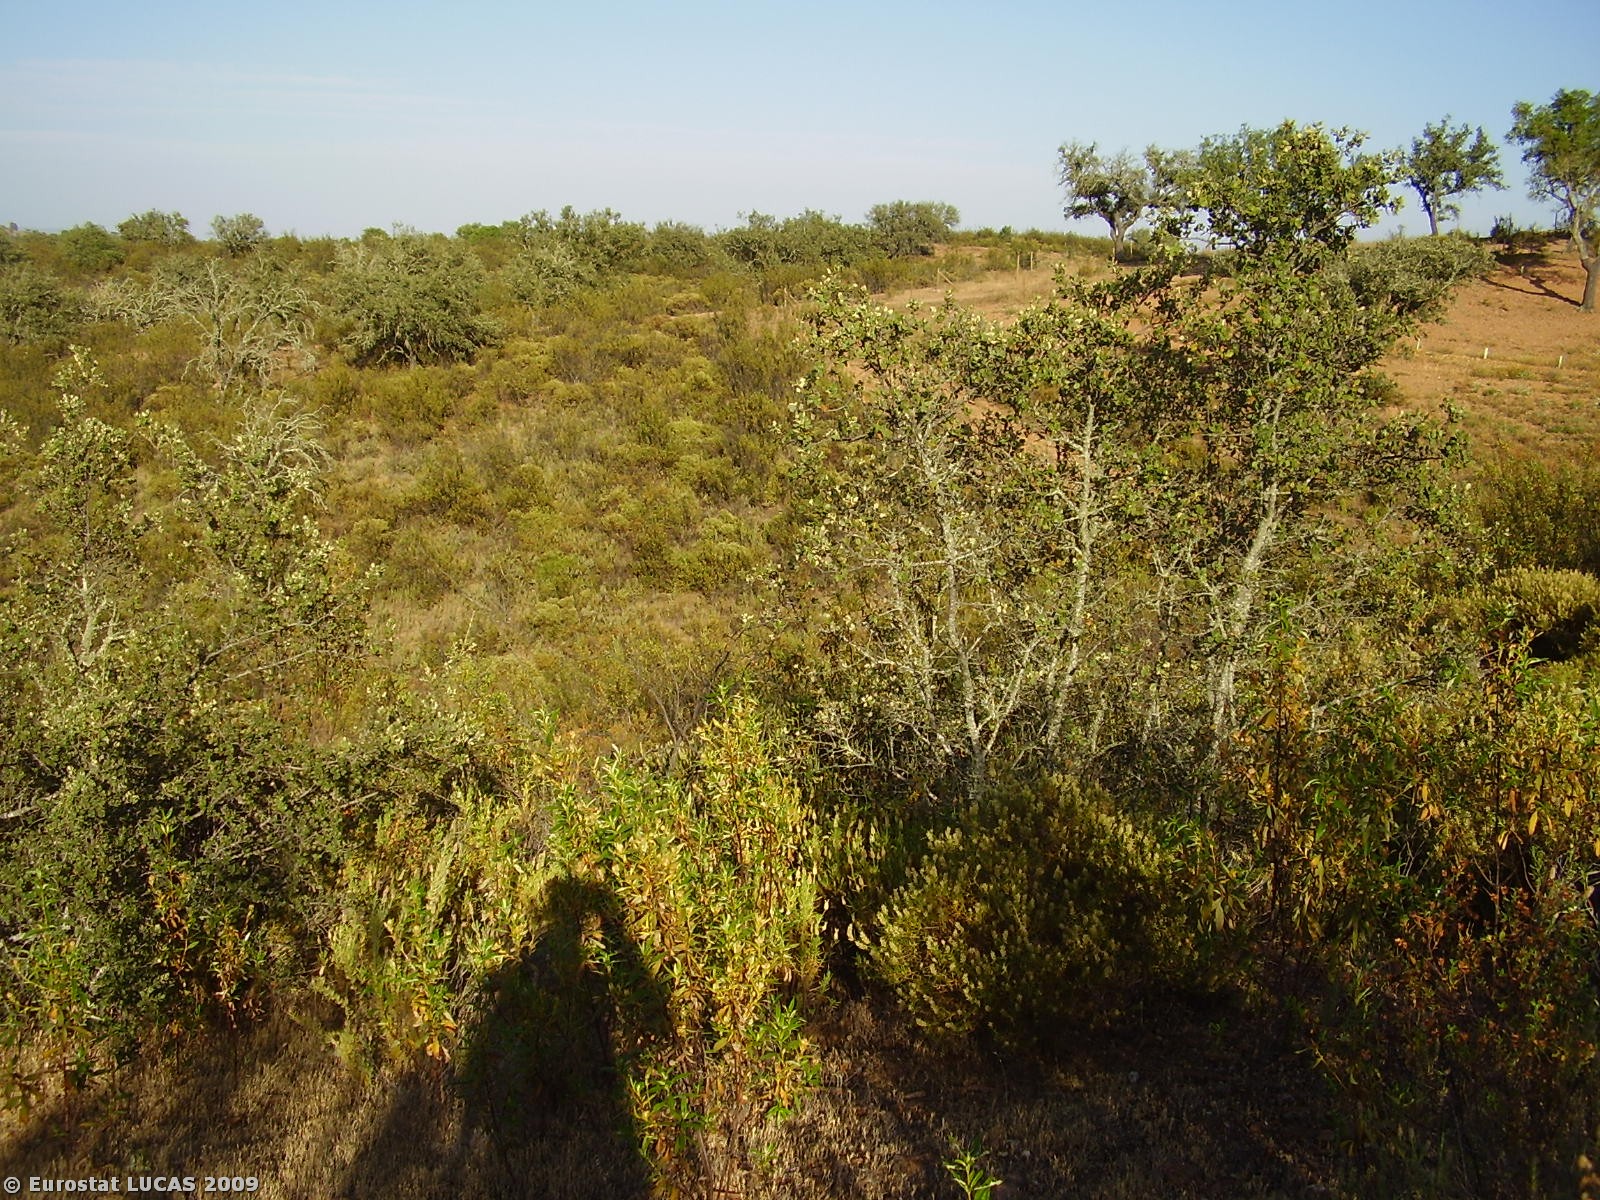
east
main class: Shrubland
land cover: Shrubland with sparse tree cover
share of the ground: 50 - 75 %
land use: Fallow land
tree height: > 5 m
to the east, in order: Shrubland with sparse tree cover; Tracks; Shrubland with sparse tree cover; Tracks; Oats
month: May
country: PT
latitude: 37.7776
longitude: -7.4879
